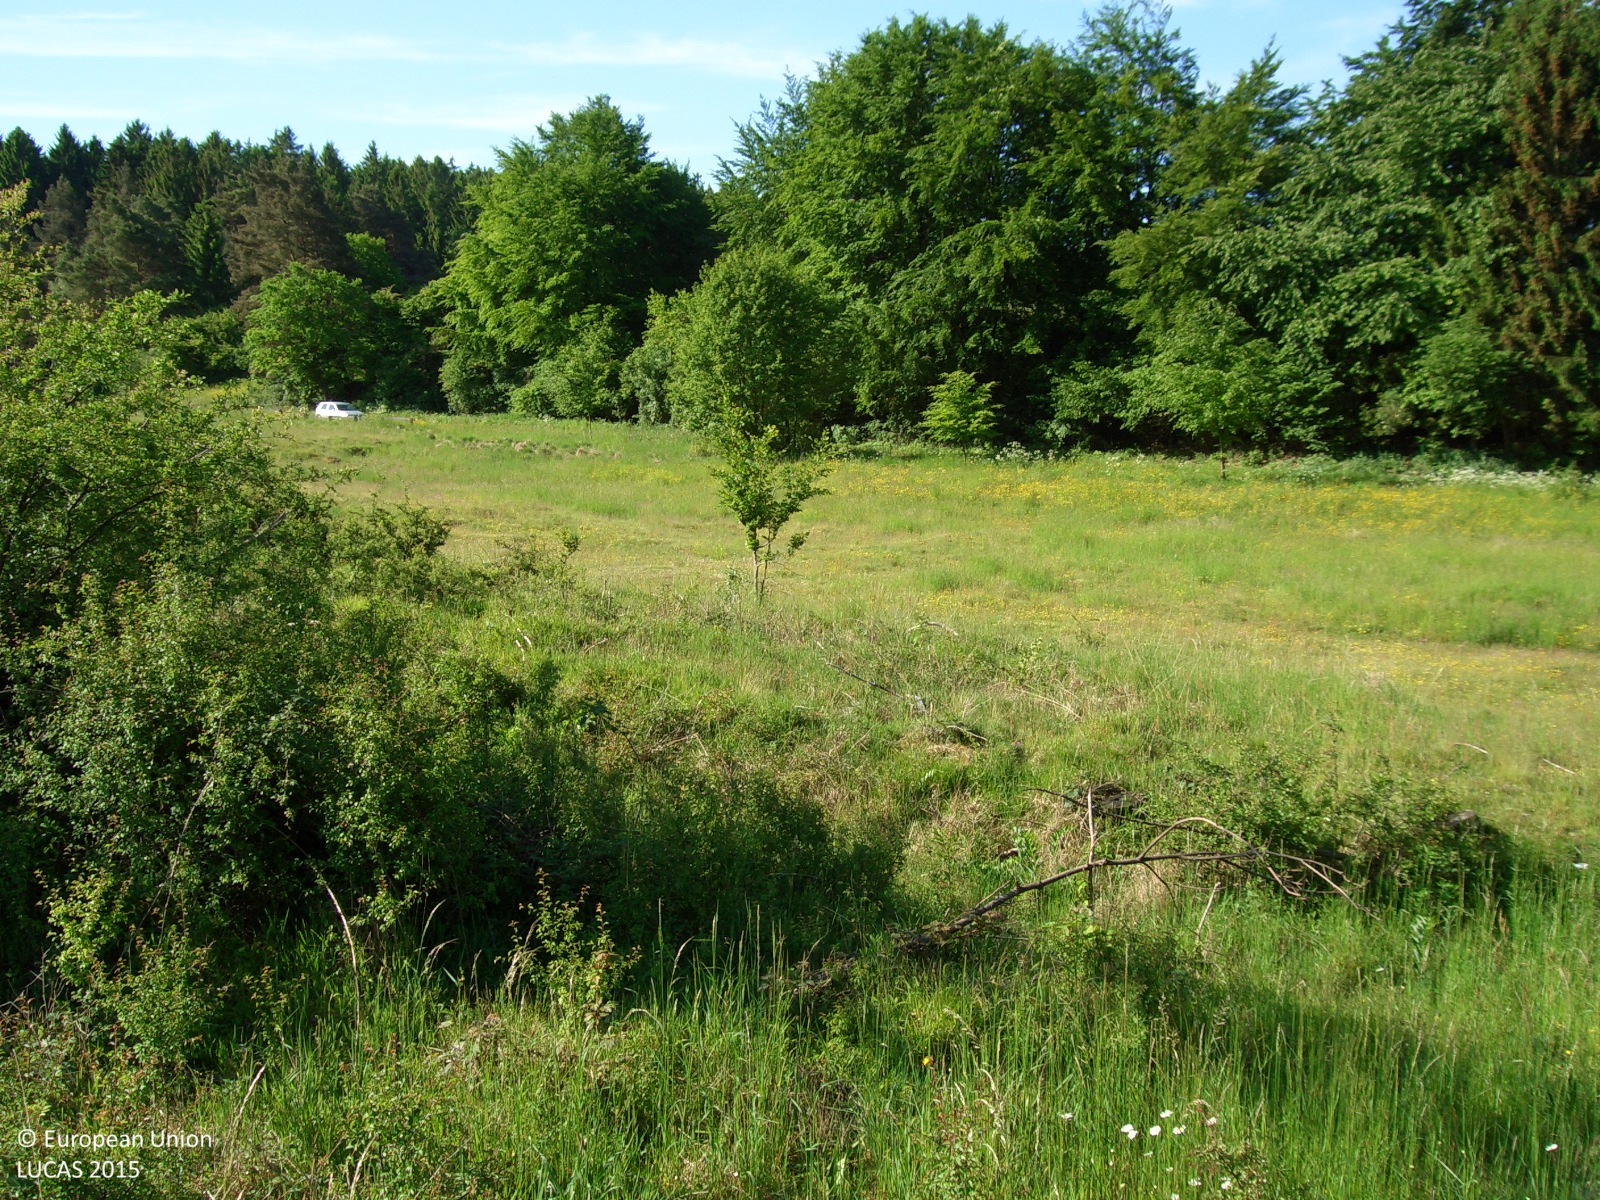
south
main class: Woodland
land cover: Broadleaved woodland
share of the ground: 10 - 25 %
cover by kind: herbaceous plants 80 %, broadleaved forest trees 20 %
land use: Forestry
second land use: Amenities, museums, leisure
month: June
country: DE
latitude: 50.7344
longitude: 6.2446
